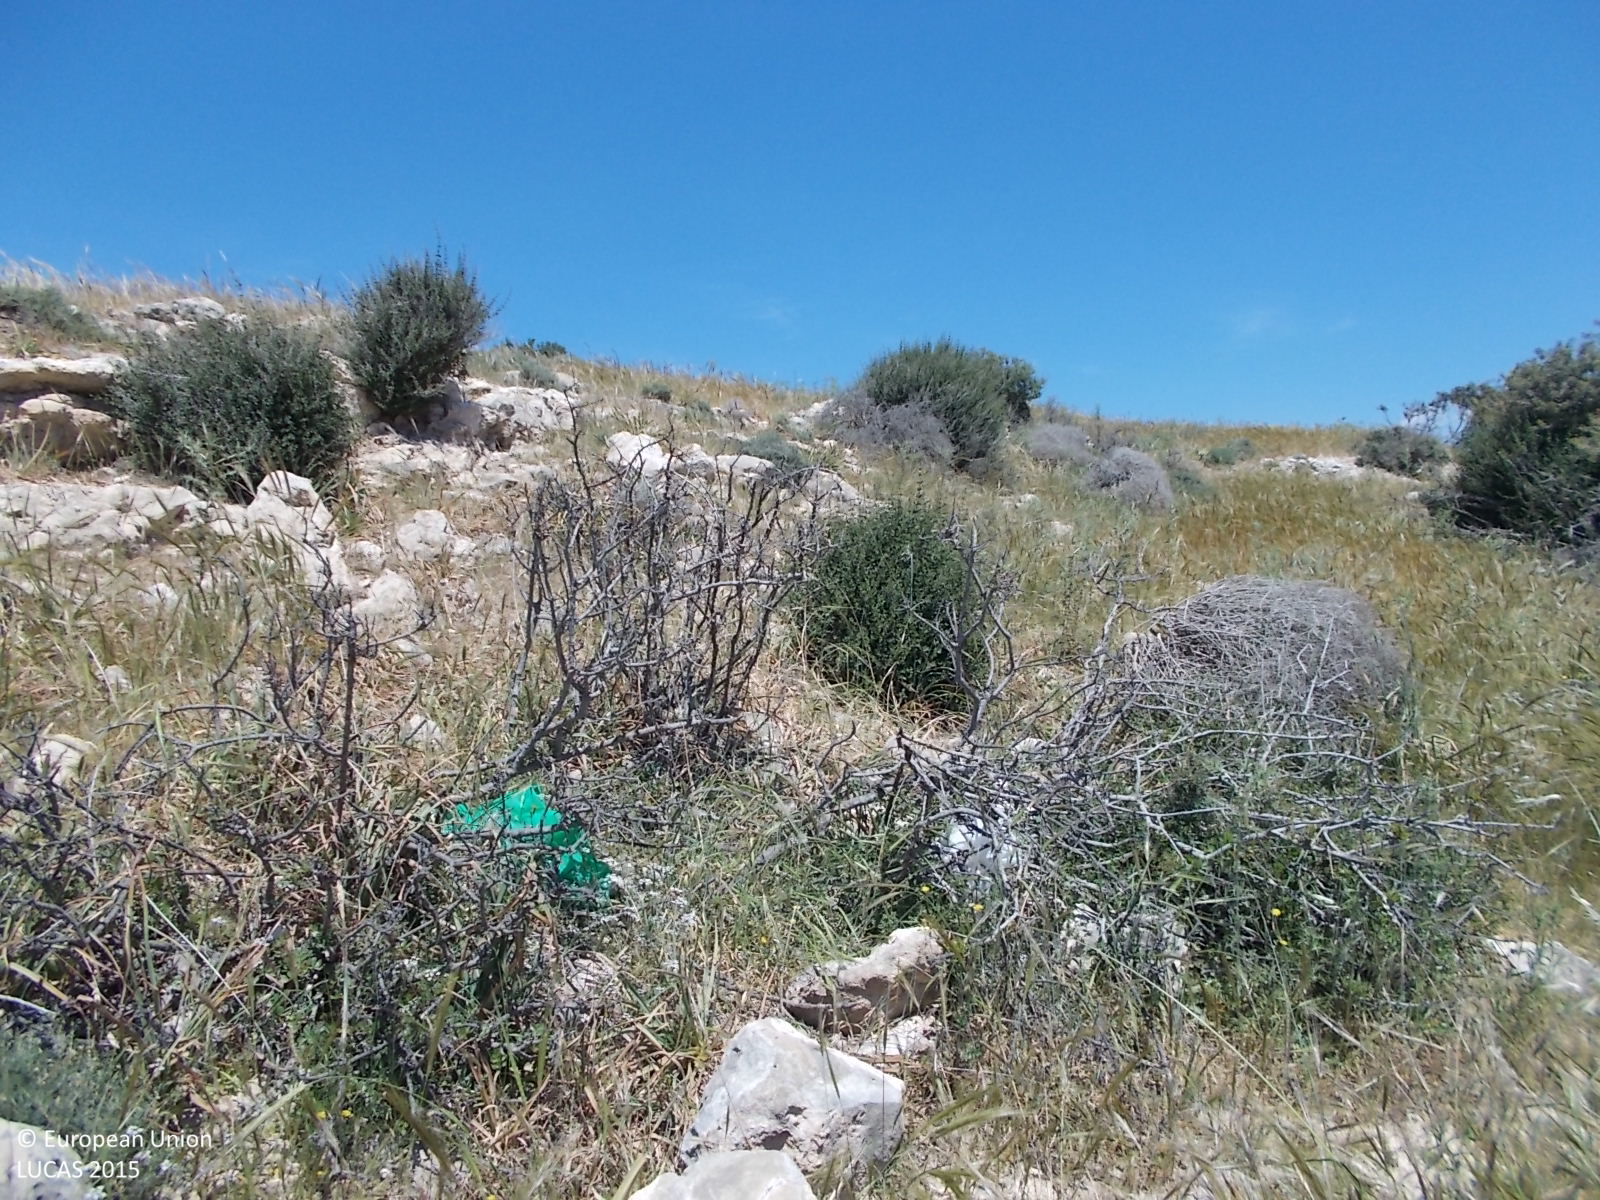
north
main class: Shrubland
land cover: Shrubland without tree cover
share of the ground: > 75 %
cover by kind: shrubs 75 %, herbaceous plants 15 %, unconsolidated bare surface 10 %
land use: Agriculture (excluding fallow land and kitchen gardens)
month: April
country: CY
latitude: 34.7274
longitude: 33.1134
